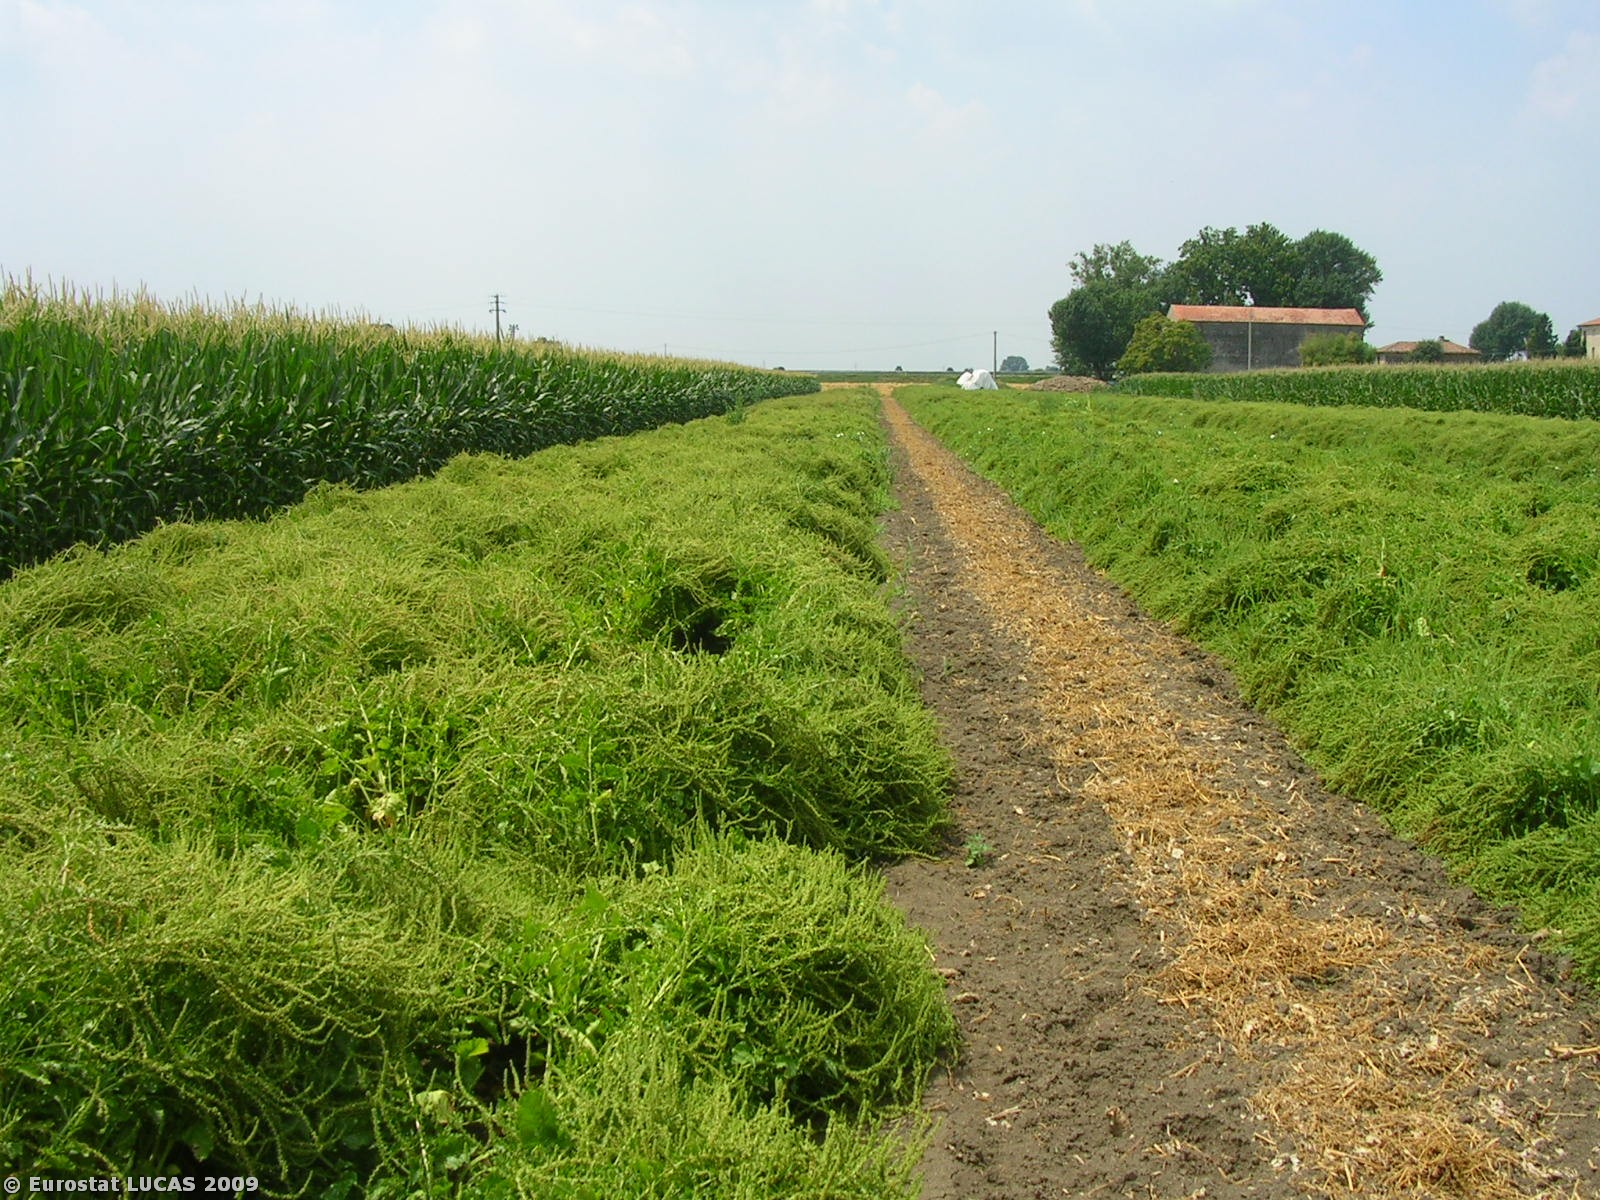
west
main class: Cropland
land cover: Sugar beet
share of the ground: 50 - 75 %
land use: Agriculture (excluding fallow land and kitchen gardens)
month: July
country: IT
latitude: 45.2573
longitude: 11.6410
